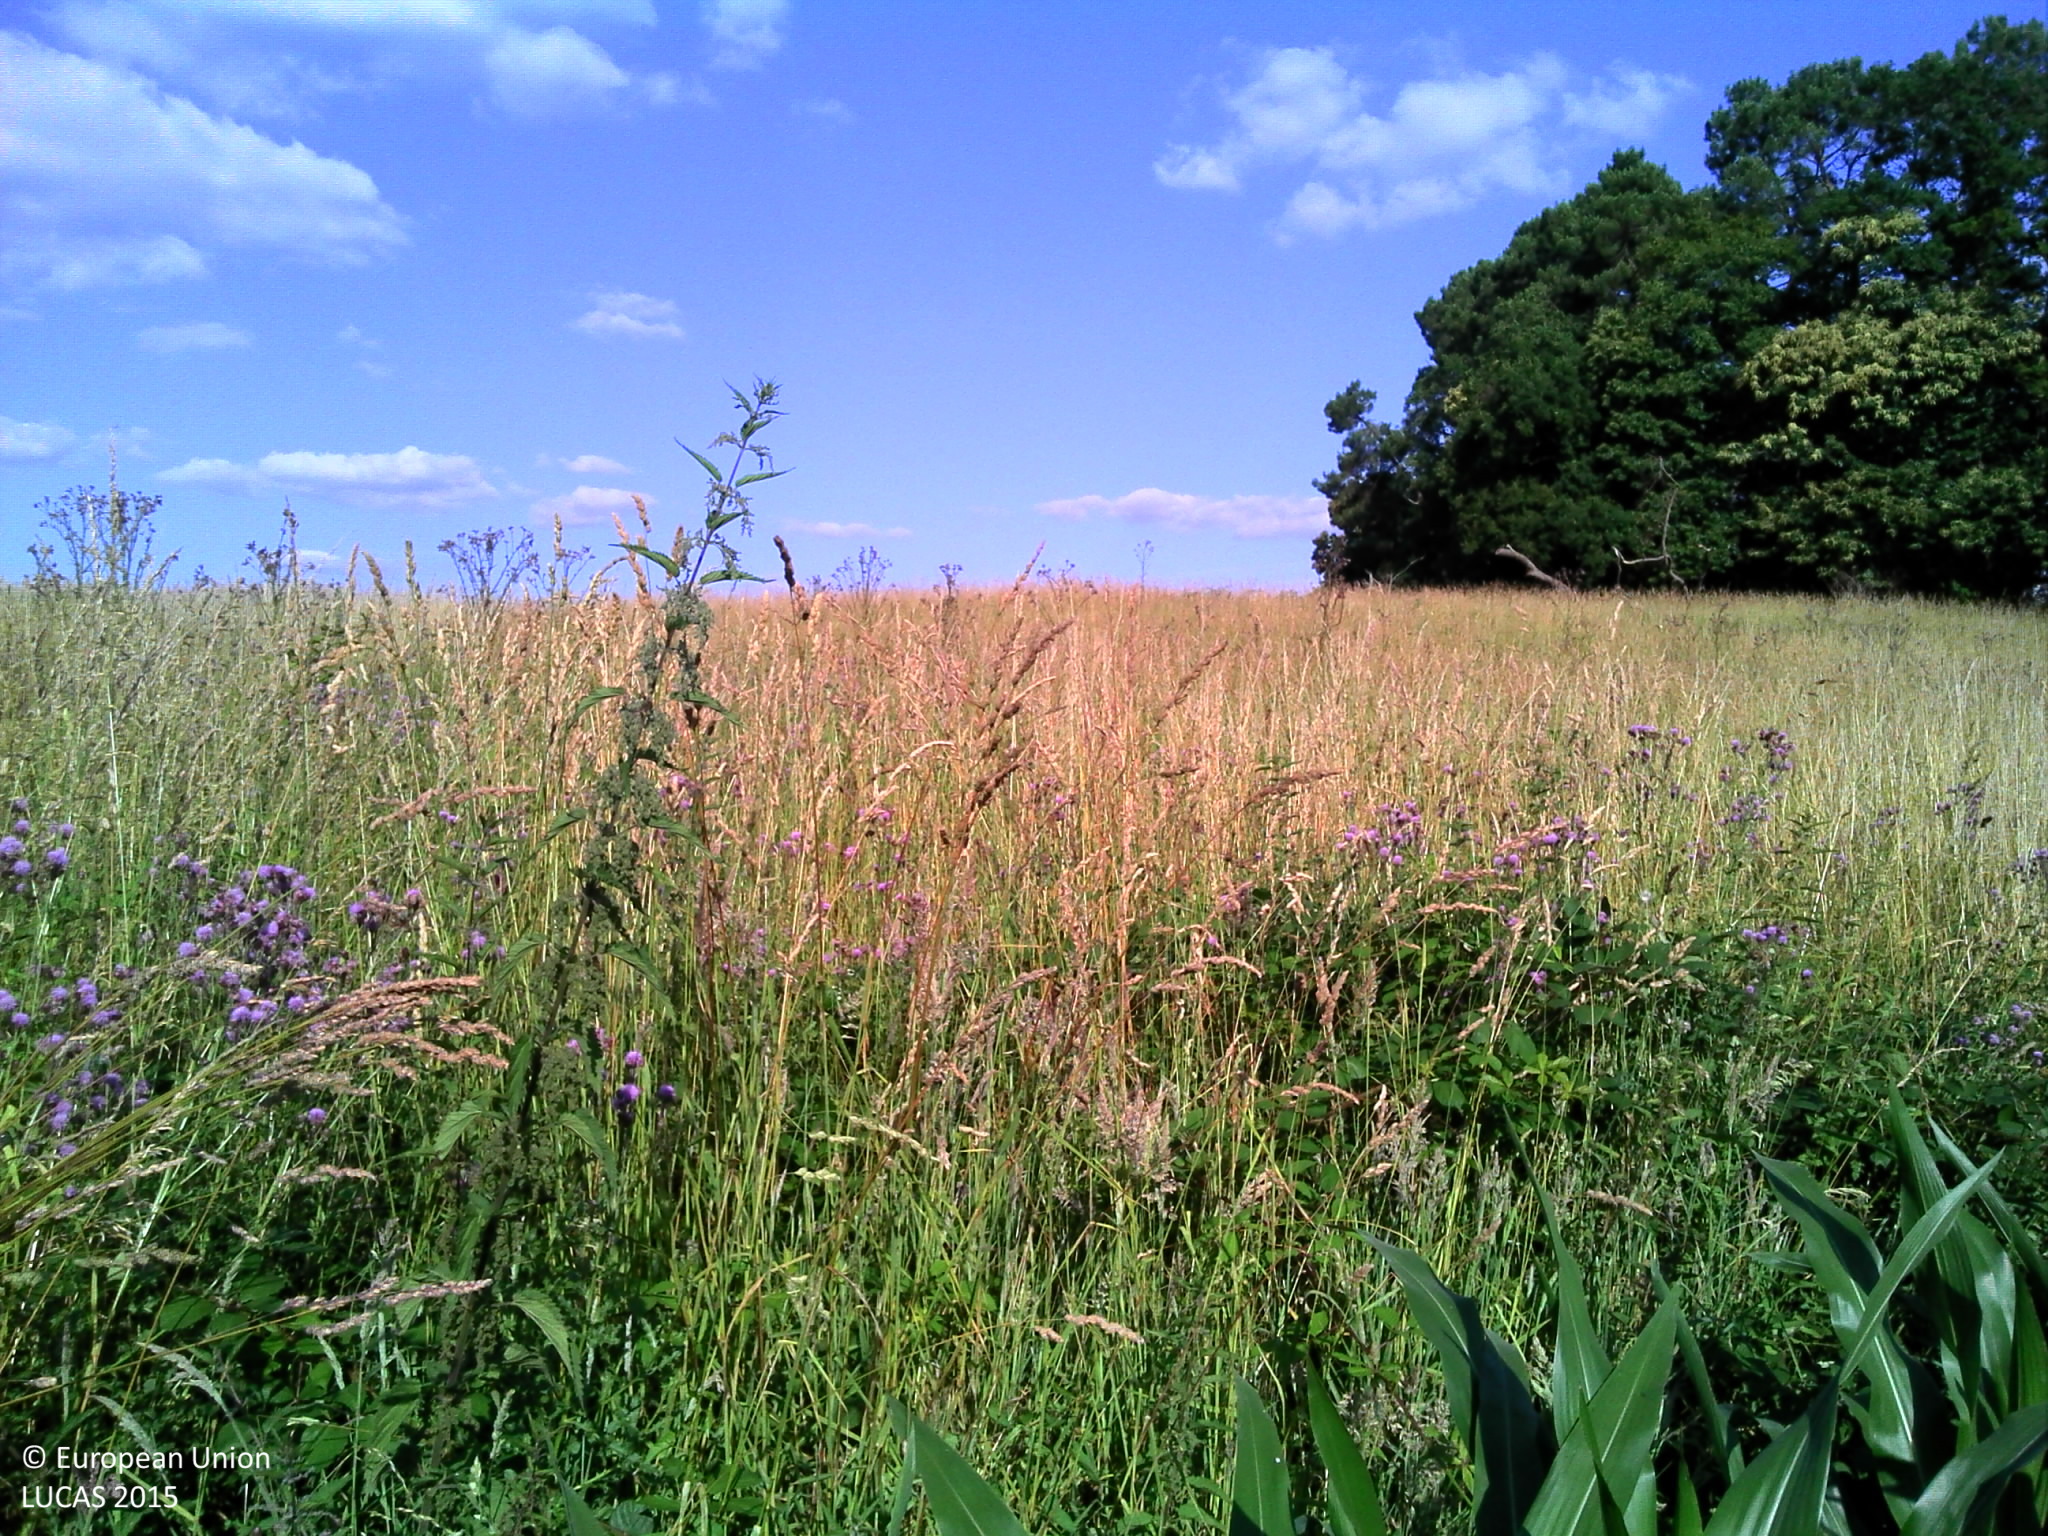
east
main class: Cropland
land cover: Maize
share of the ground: > 75 %
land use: Agriculture (excluding fallow land and kitchen gardens)
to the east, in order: Maize; Grassland without tree/shrub cover; Soya; Ditches and canals; Grass margins; Maize
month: June
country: FR
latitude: 43.6031
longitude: -0.4531
